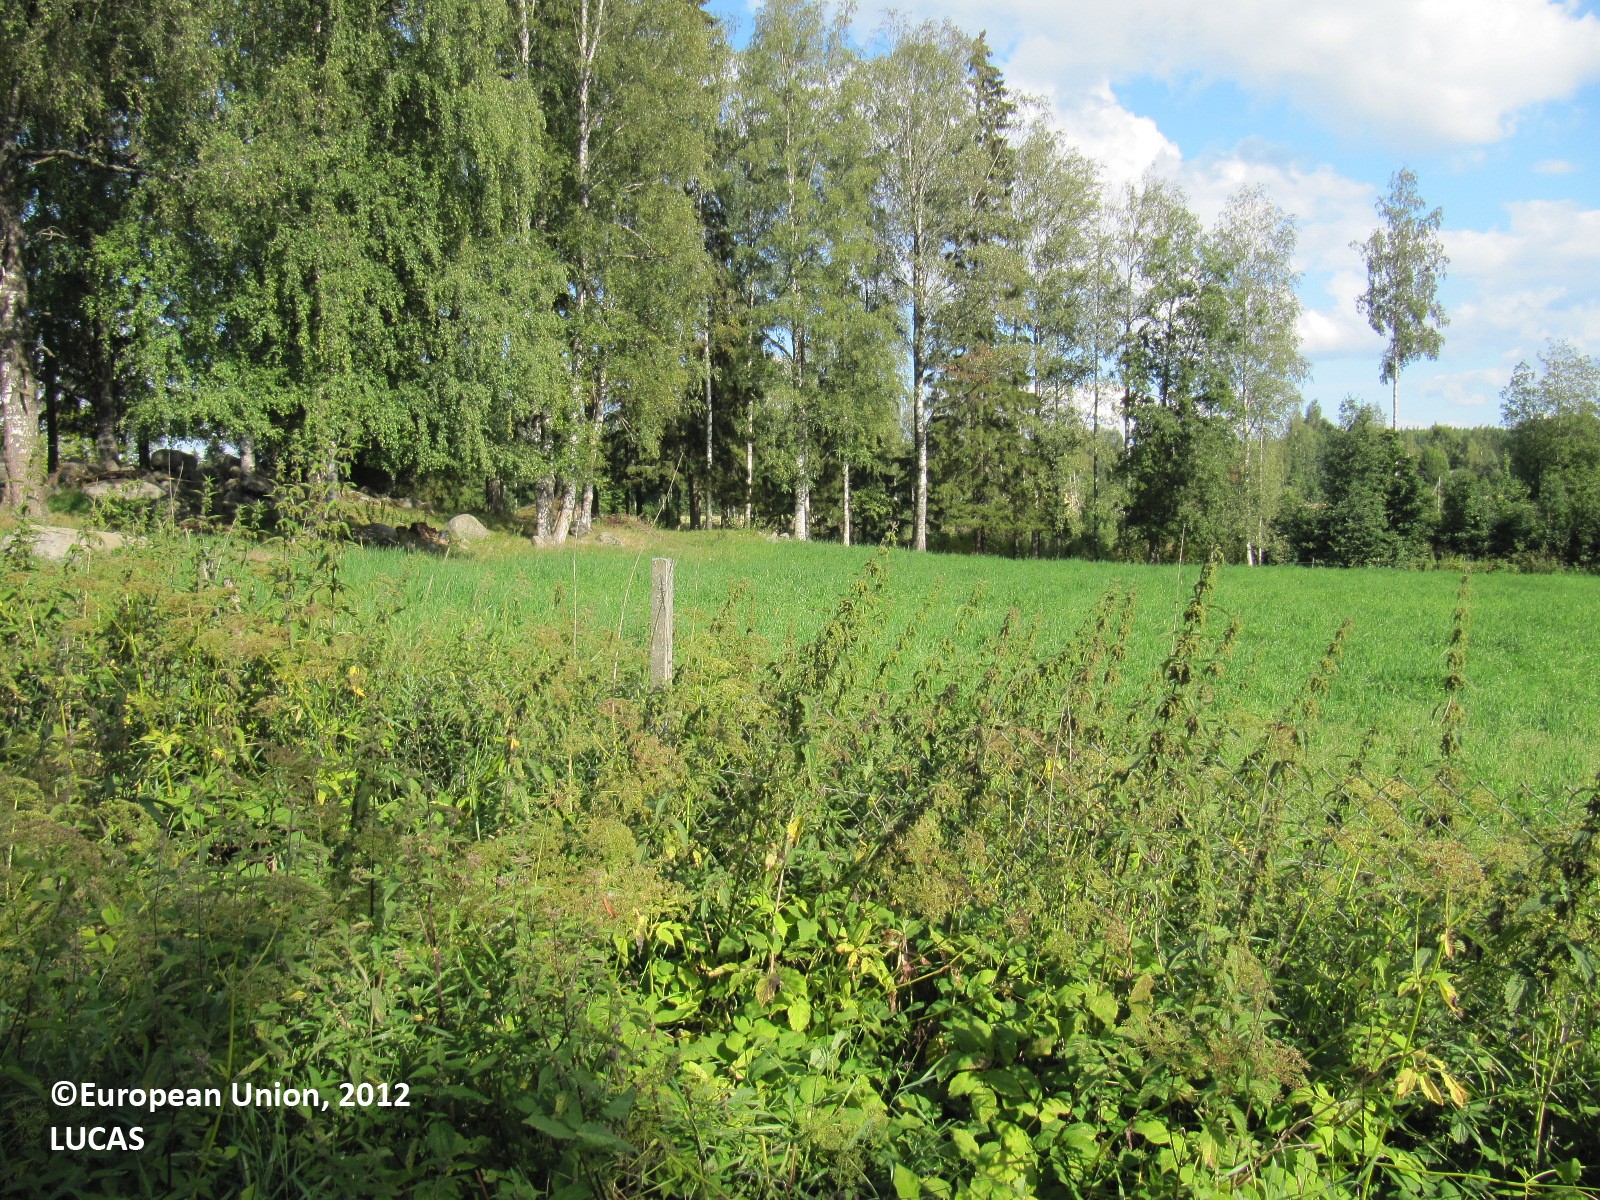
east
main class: Cropland
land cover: Other fruit trees and berries
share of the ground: 50 - 75 %
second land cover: Apple fruit
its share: 25 - 50 %
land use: Kitchen garden
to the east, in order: Other fruit trees and berries; Fences; Shruby margins; Grassland without tree/shrub cover; Other mixed woodland; Fences; Shrubland with sparse tree cover; Ditches and canals; Grass margins; Paved roads, cycling and walking lanes; Grass margins; Ditches and canals; Broadleaved woodland; Ditches and canals; Spontaneously vegetated surfaces; Oats
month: August
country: FI
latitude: 60.5887
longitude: 24.4348
